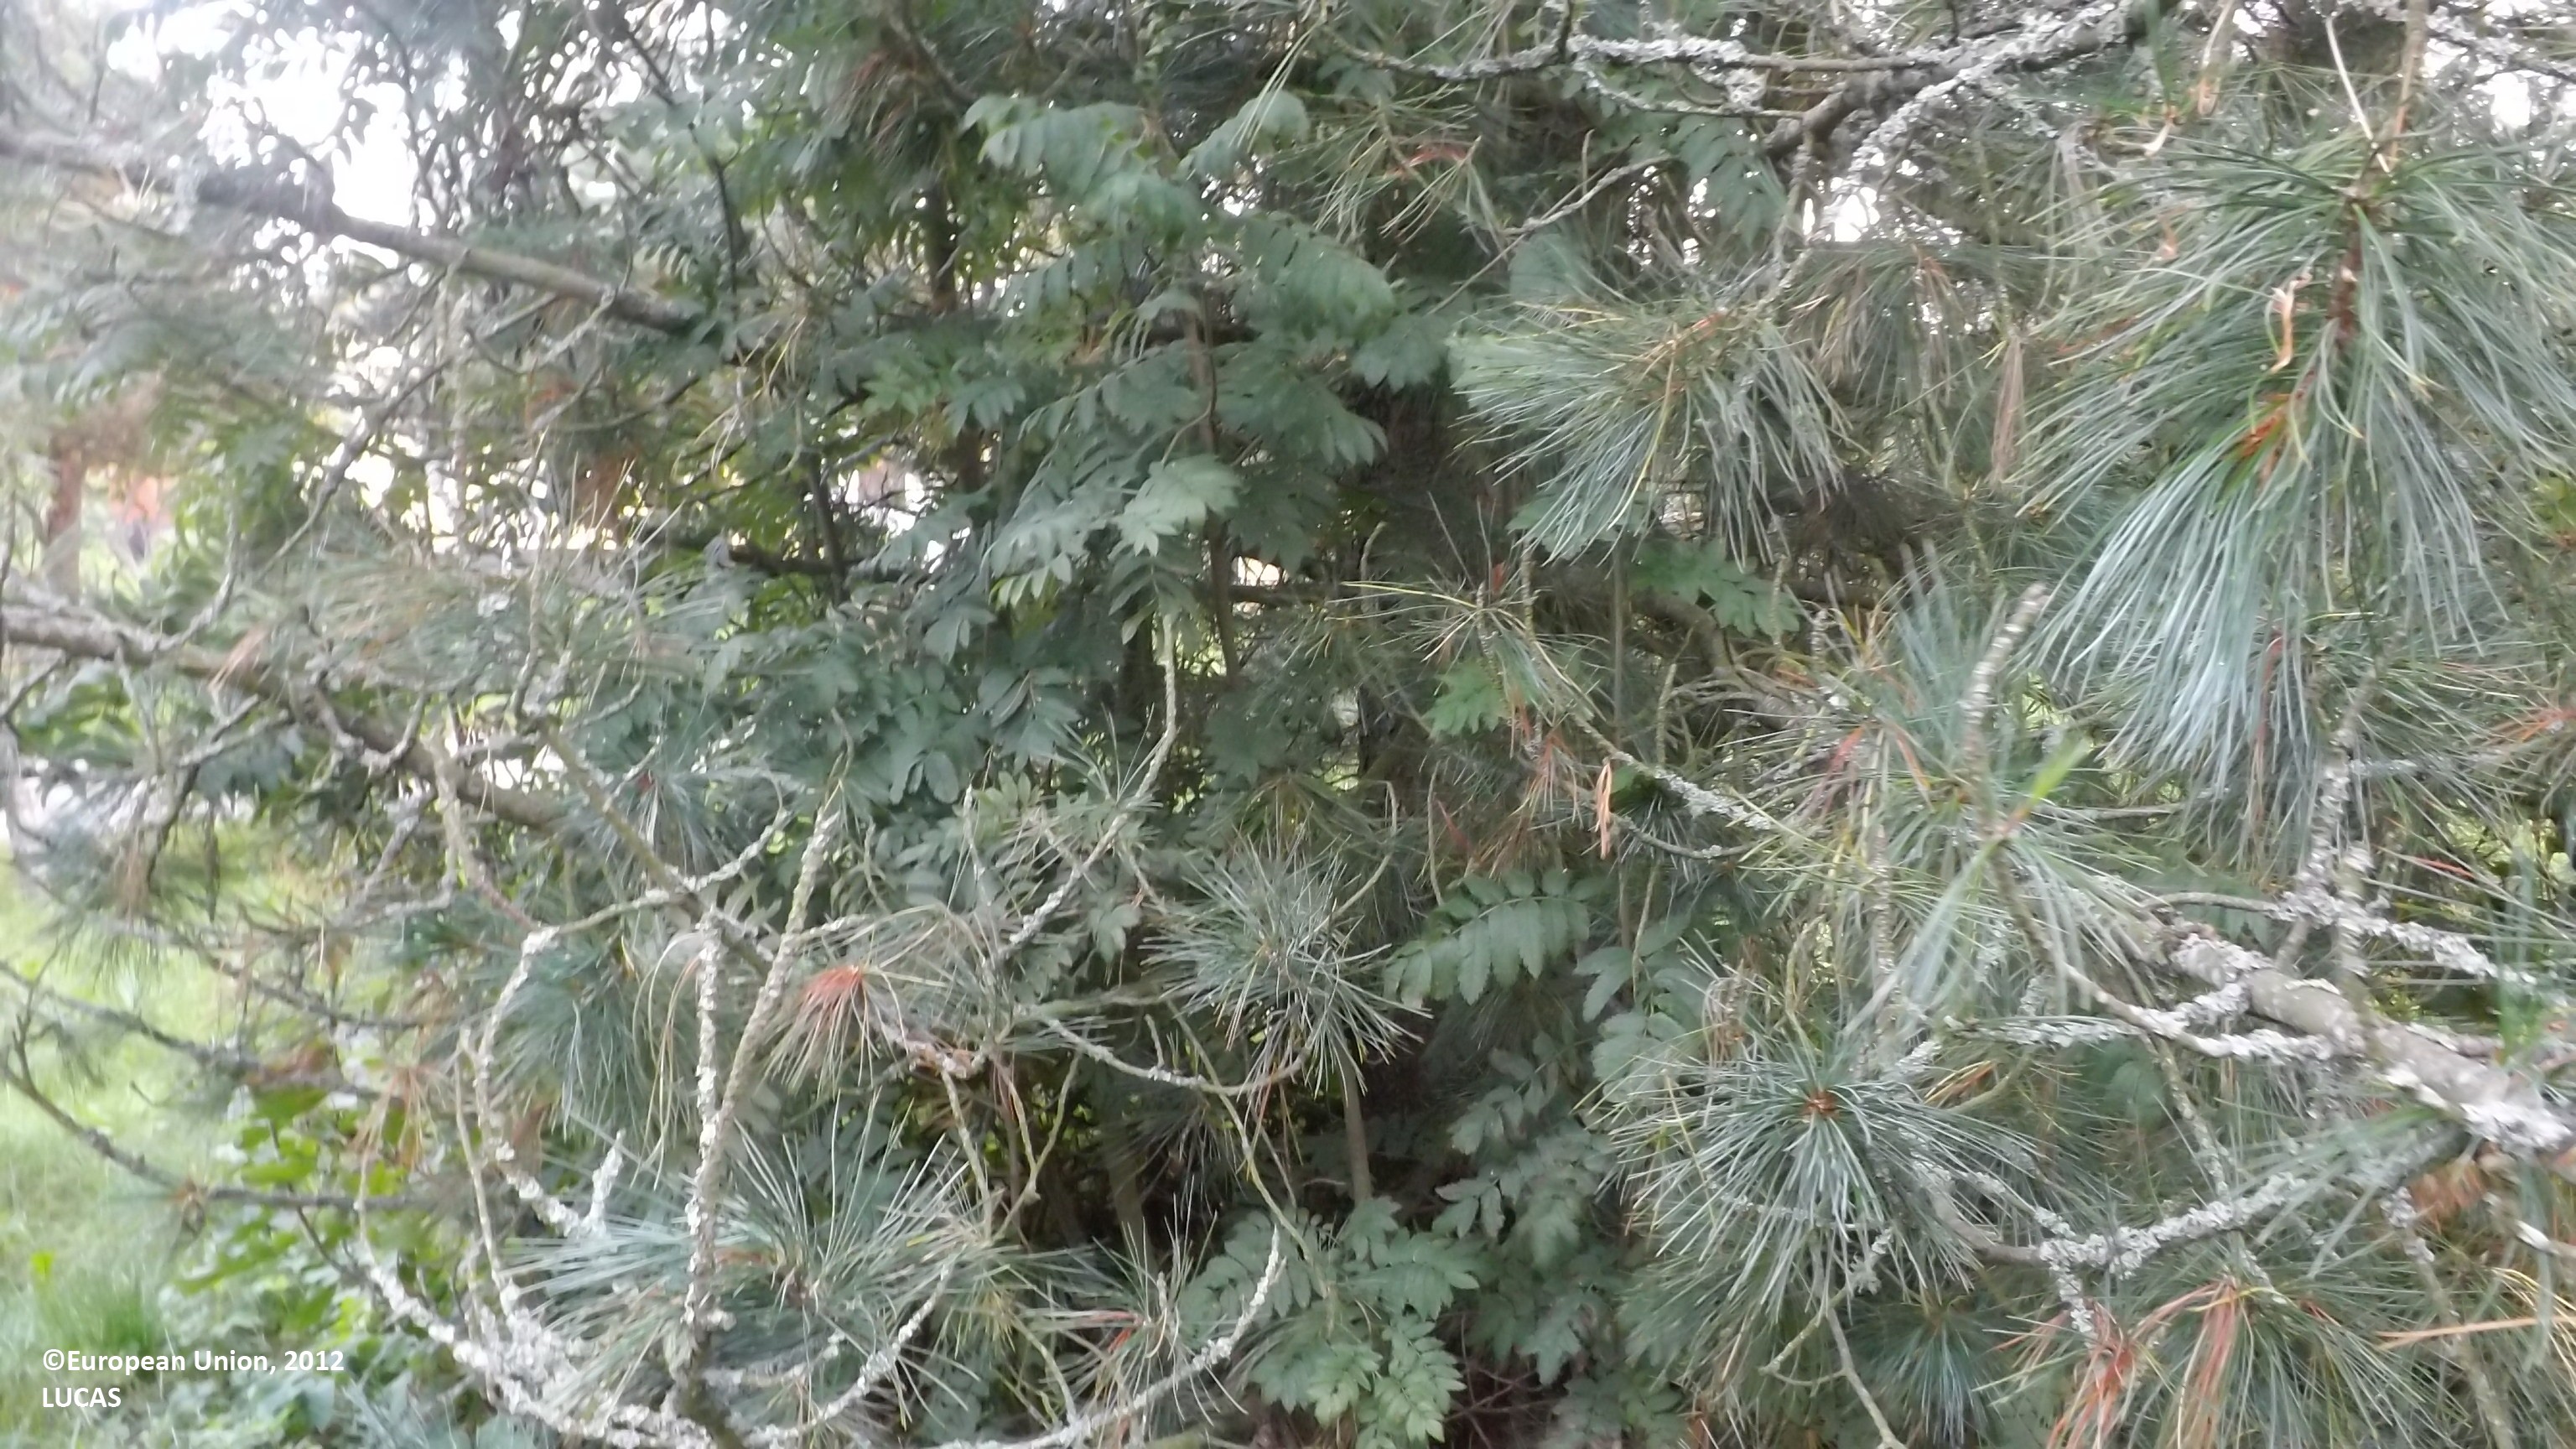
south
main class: Grassland
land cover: Grassland with sparse tree/shrub cover
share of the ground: 25 - 50 %
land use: Residential
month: August
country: FI
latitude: 63.8579
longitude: 23.4637
